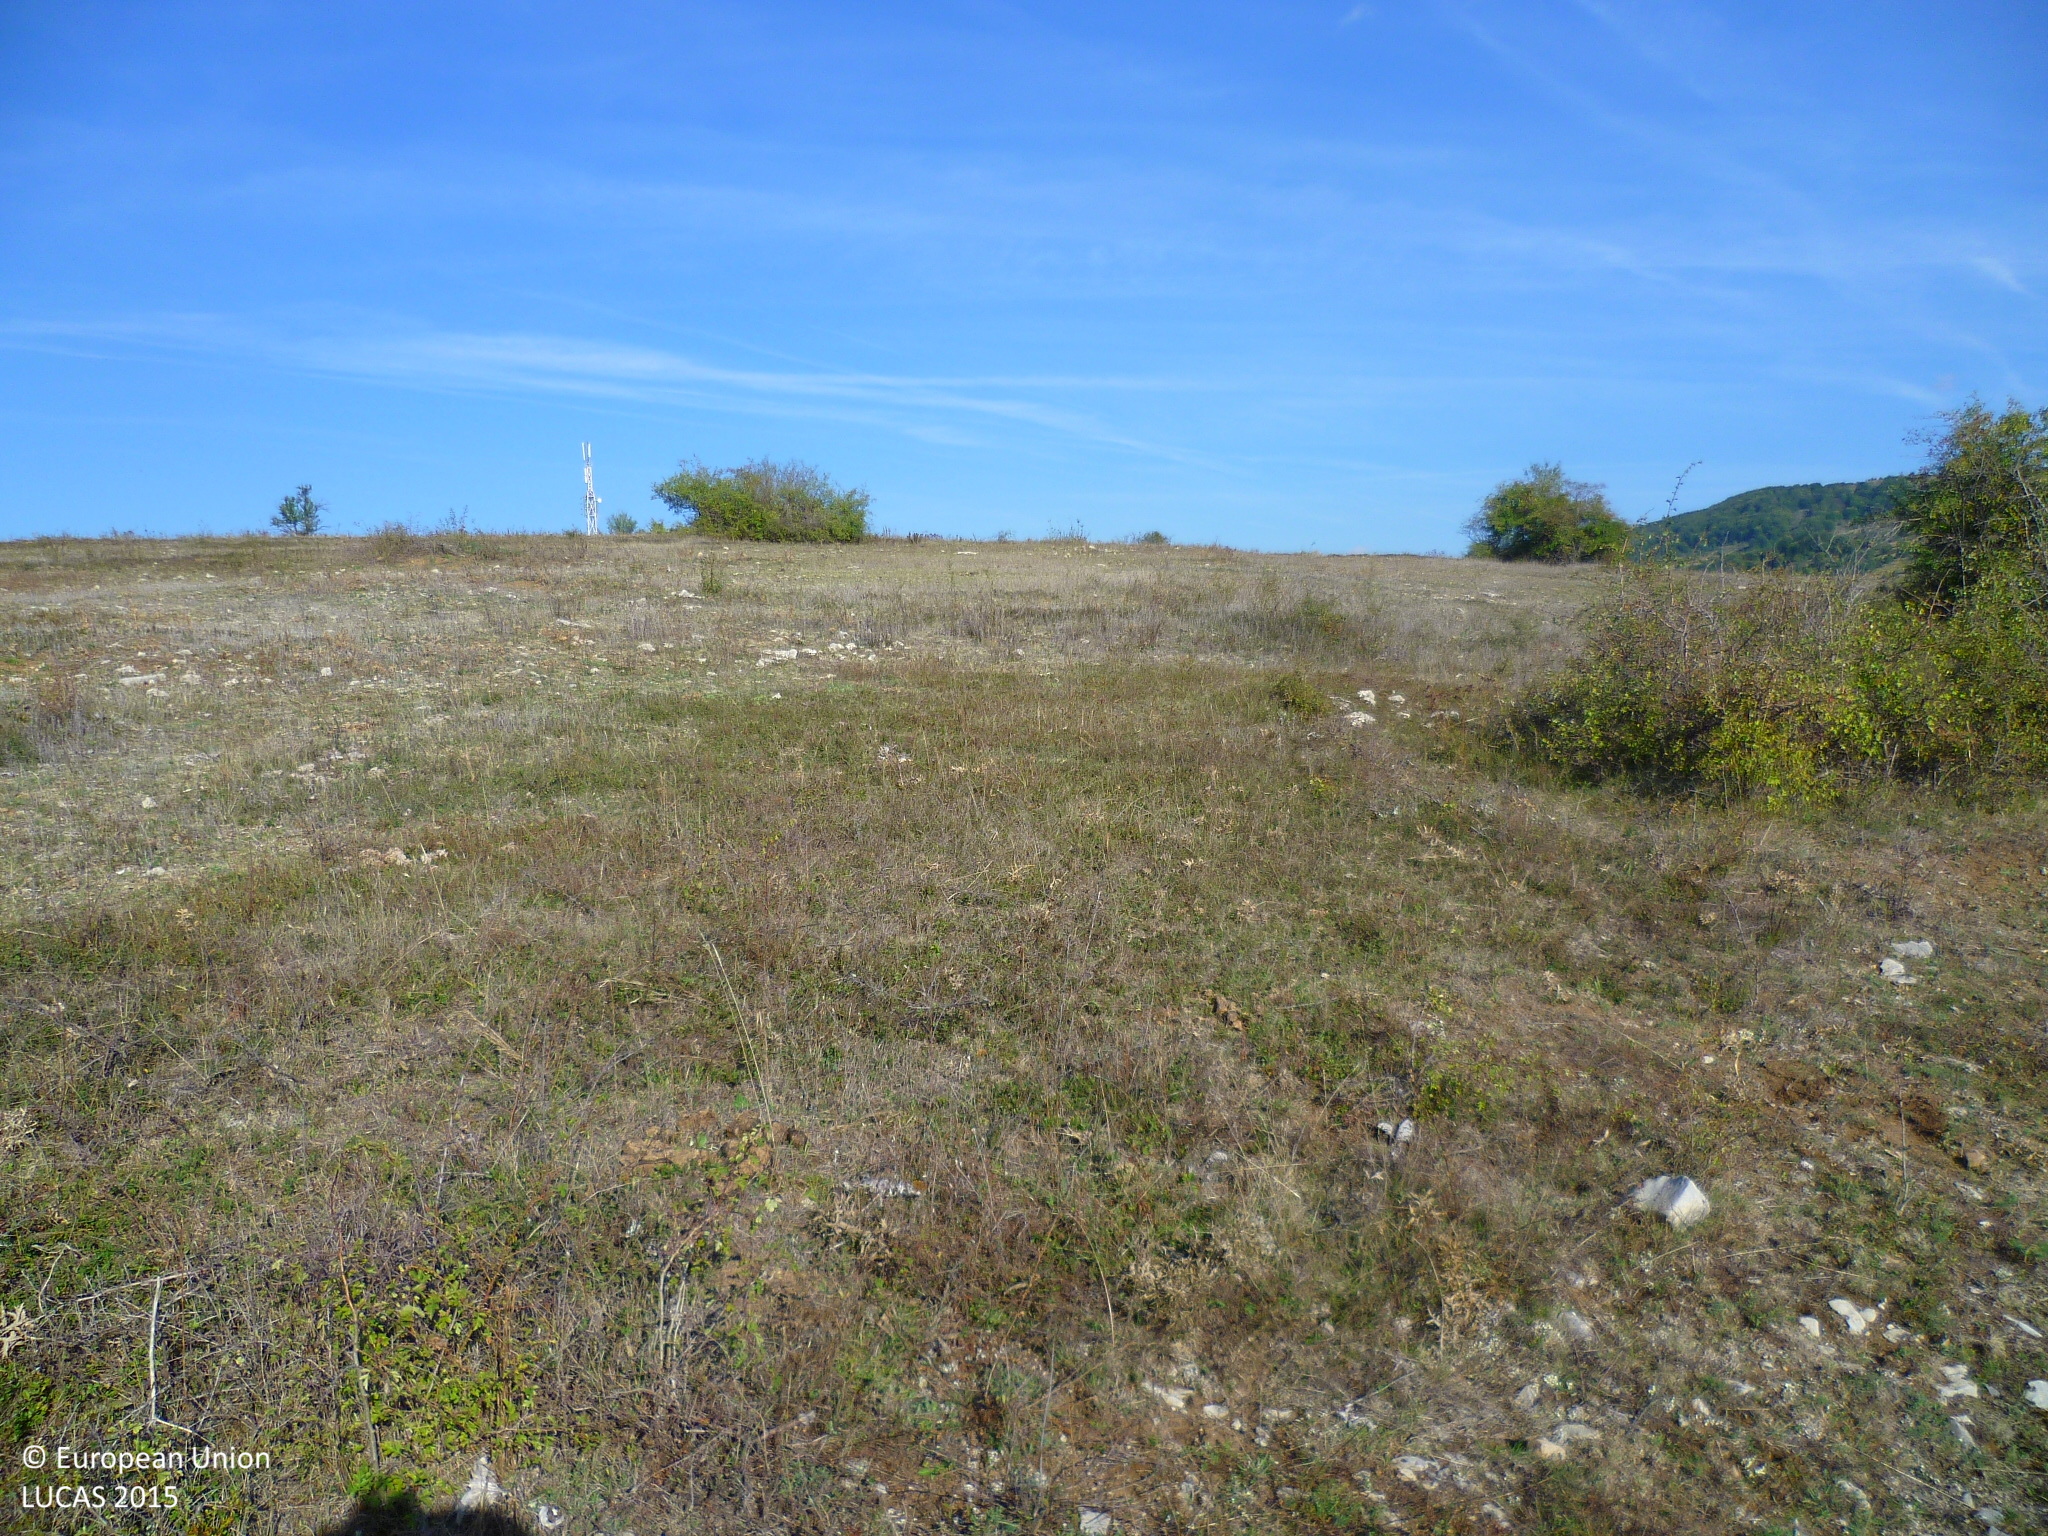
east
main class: Grassland
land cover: Grassland with sparse tree/shrub cover
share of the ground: > 75 %
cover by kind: herbaceous plants 65 %, unconsolidated bare surface 20 %, shrubs 10 %, broadleaved forest trees 5 %
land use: Agriculture (excluding fallow land and kitchen gardens)
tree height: < 5 m
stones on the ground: 25 - 50 %
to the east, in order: Grassland with sparse tree/shrub cover
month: October
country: BG
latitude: 43.0769
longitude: 22.9659
